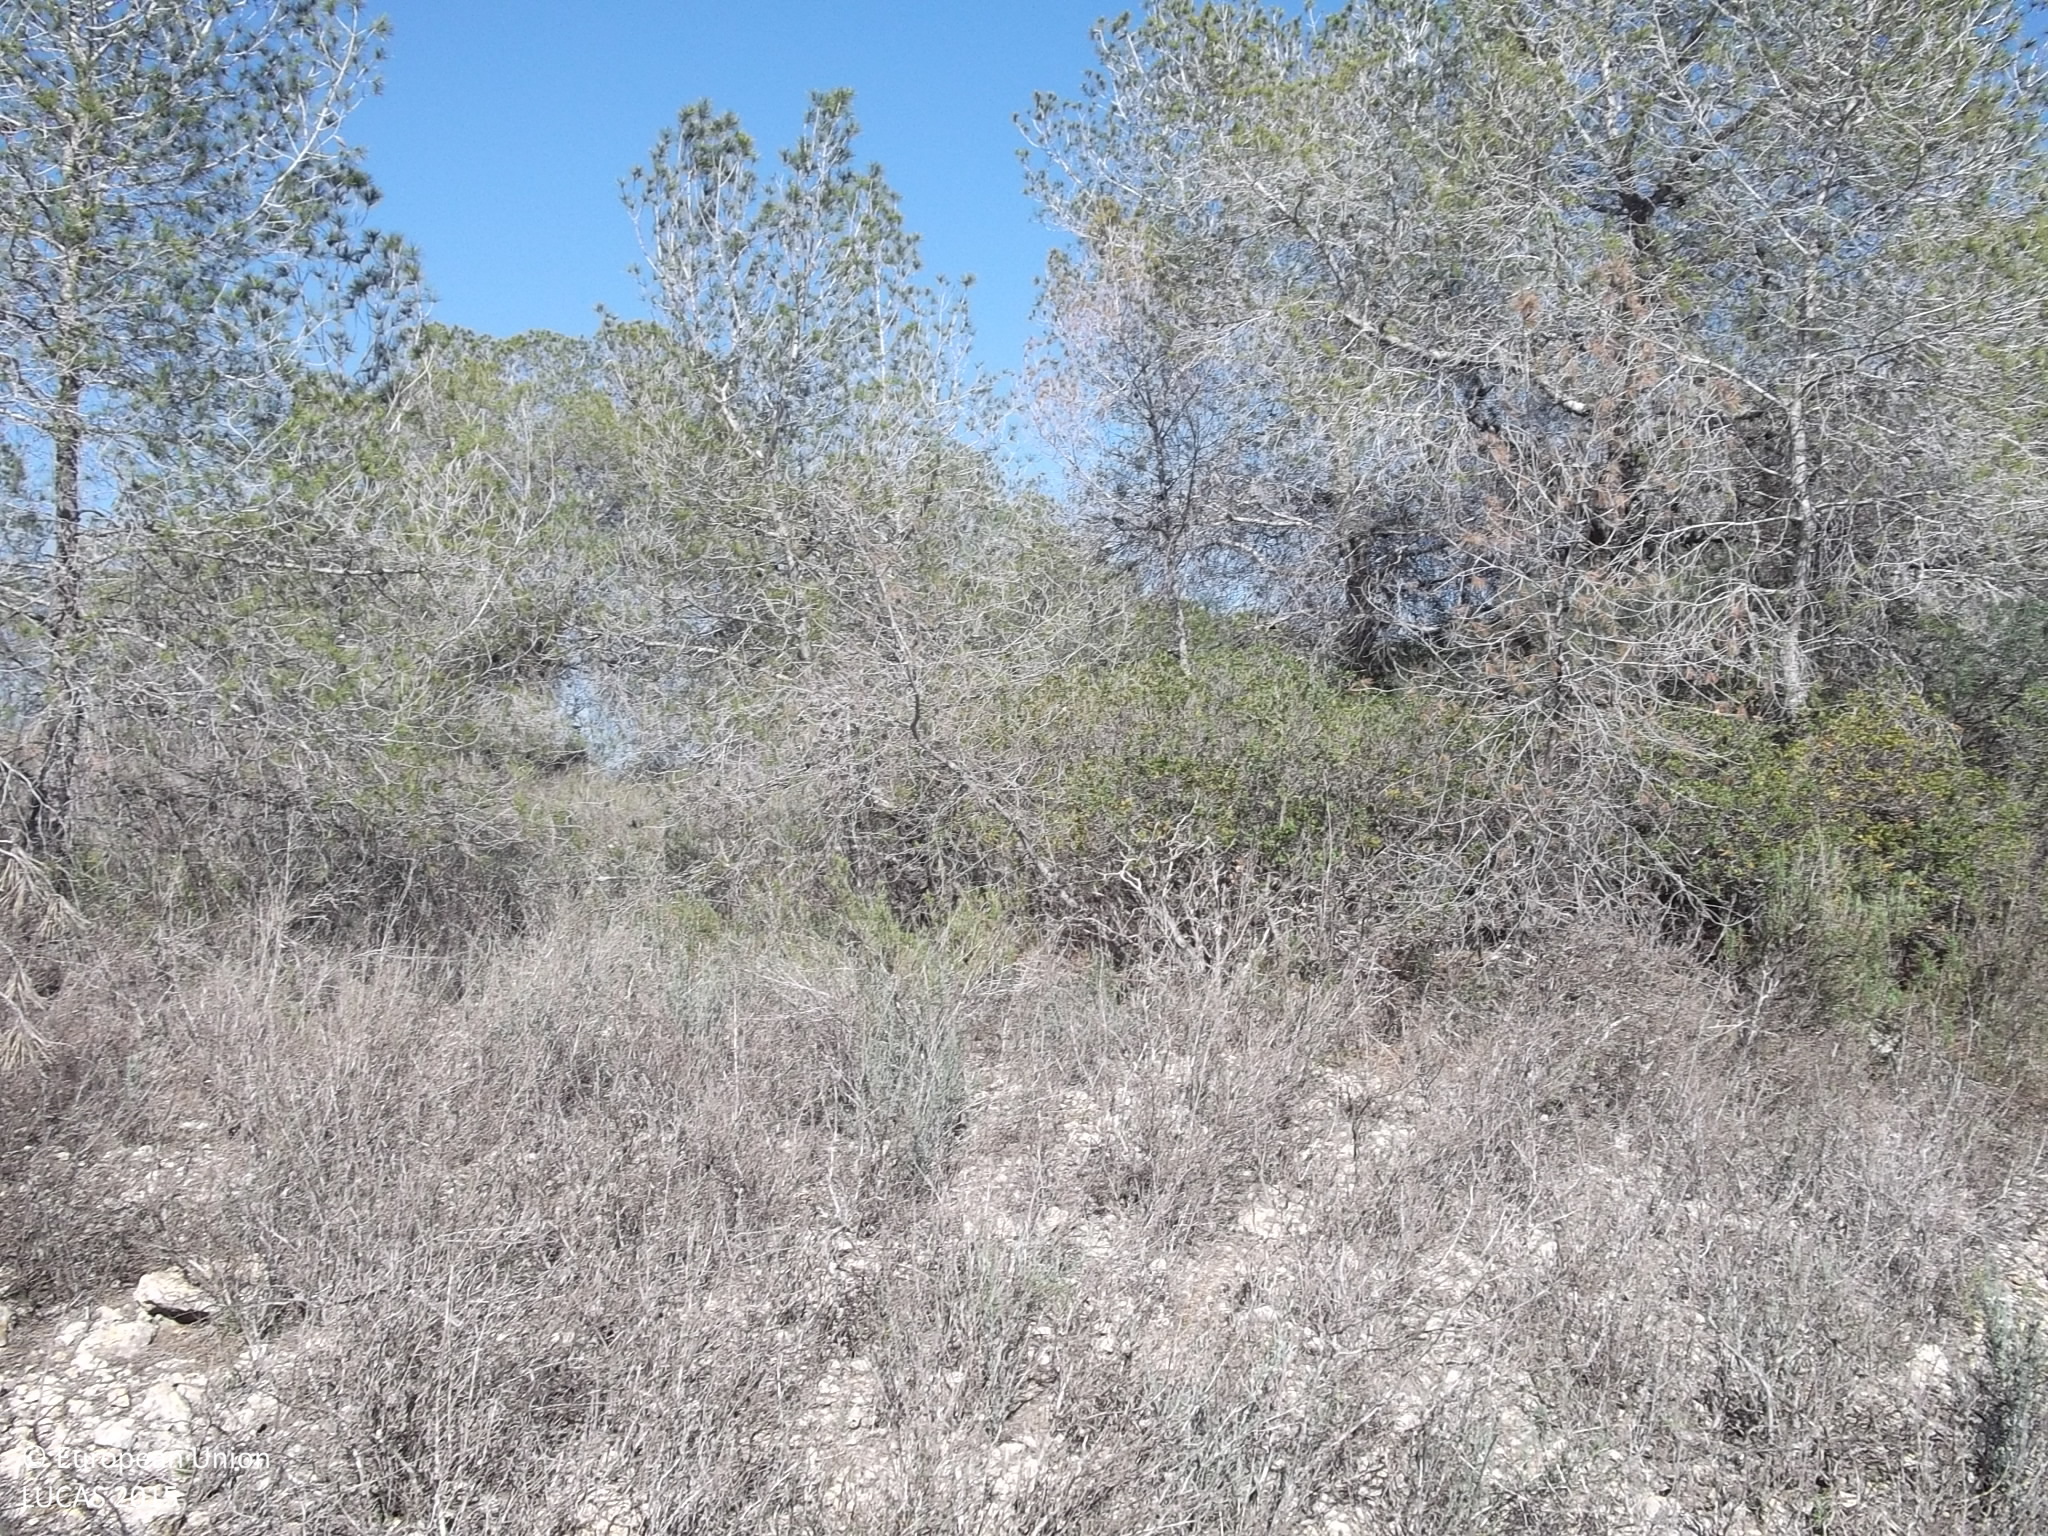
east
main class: Woodland
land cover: Pine dominated coniferous woodland
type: coniferous forest of the mediterranean region
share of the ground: 10 - 25 %
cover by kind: shrubs 30 %, consolidated bare surface 30 %, coniferous forest trees 20 %, herbaceous plants 20 %
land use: Semi-natural and natural areas not in use
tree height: > 5 m
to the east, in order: Pine dominated coniferous woodland; Spontaneously vegetated surfaces; Shrubland with sparse tree cover; Spontaneously vegetated surfaces; Shrubland with sparse tree cover; Paved roads, cycling and walking lanes; Pine dominated coniferous woodland; Paved roads, cycling and walking lanes; Shrubland with sparse tree cover; Spontaneously vegetated surfaces; Shrubland with sparse tree cover; Spontaneously vegetated surfaces
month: May
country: ES
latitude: 37.9500
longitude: -0.8275
